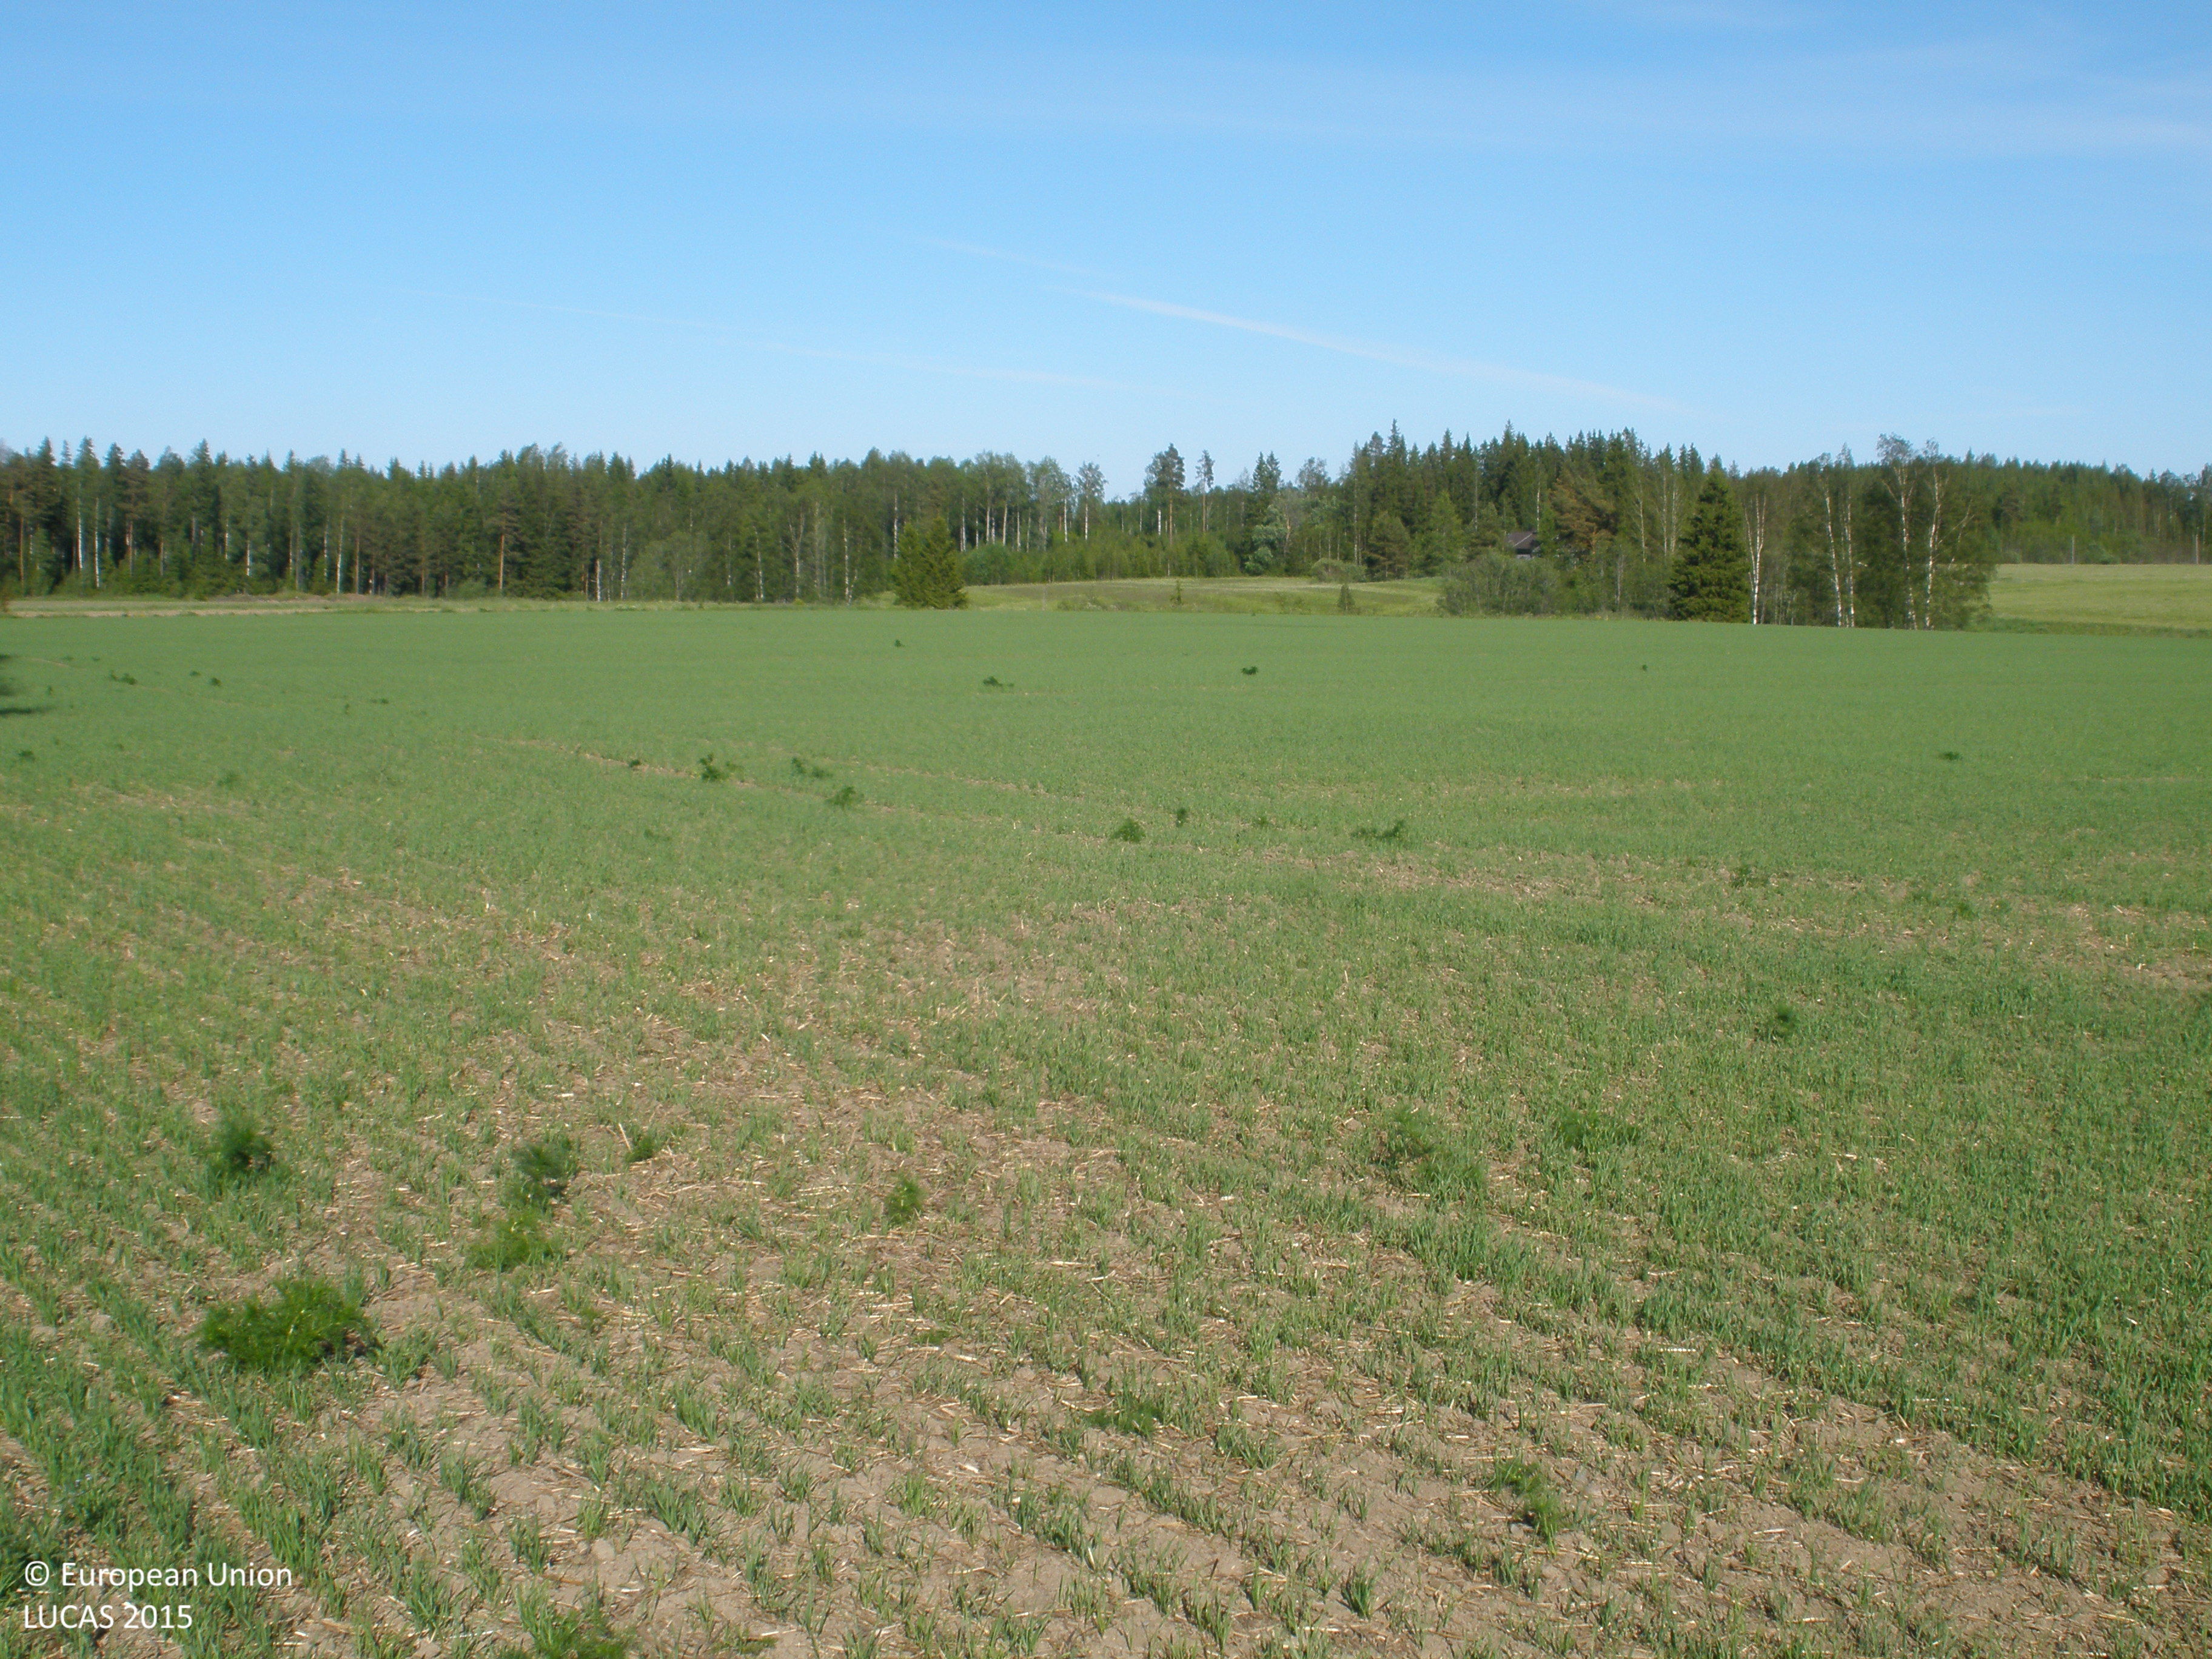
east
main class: Cropland
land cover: Common wheat
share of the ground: > 75 %
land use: Agriculture (excluding fallow land and kitchen gardens)
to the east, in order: Common wheat; Grass margins; Inland fresh running water; Grass margins; Common wheat; Ditches and canals; Grassland without tree/shrub cover
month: June
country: FI
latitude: 60.7613
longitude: 23.4264
